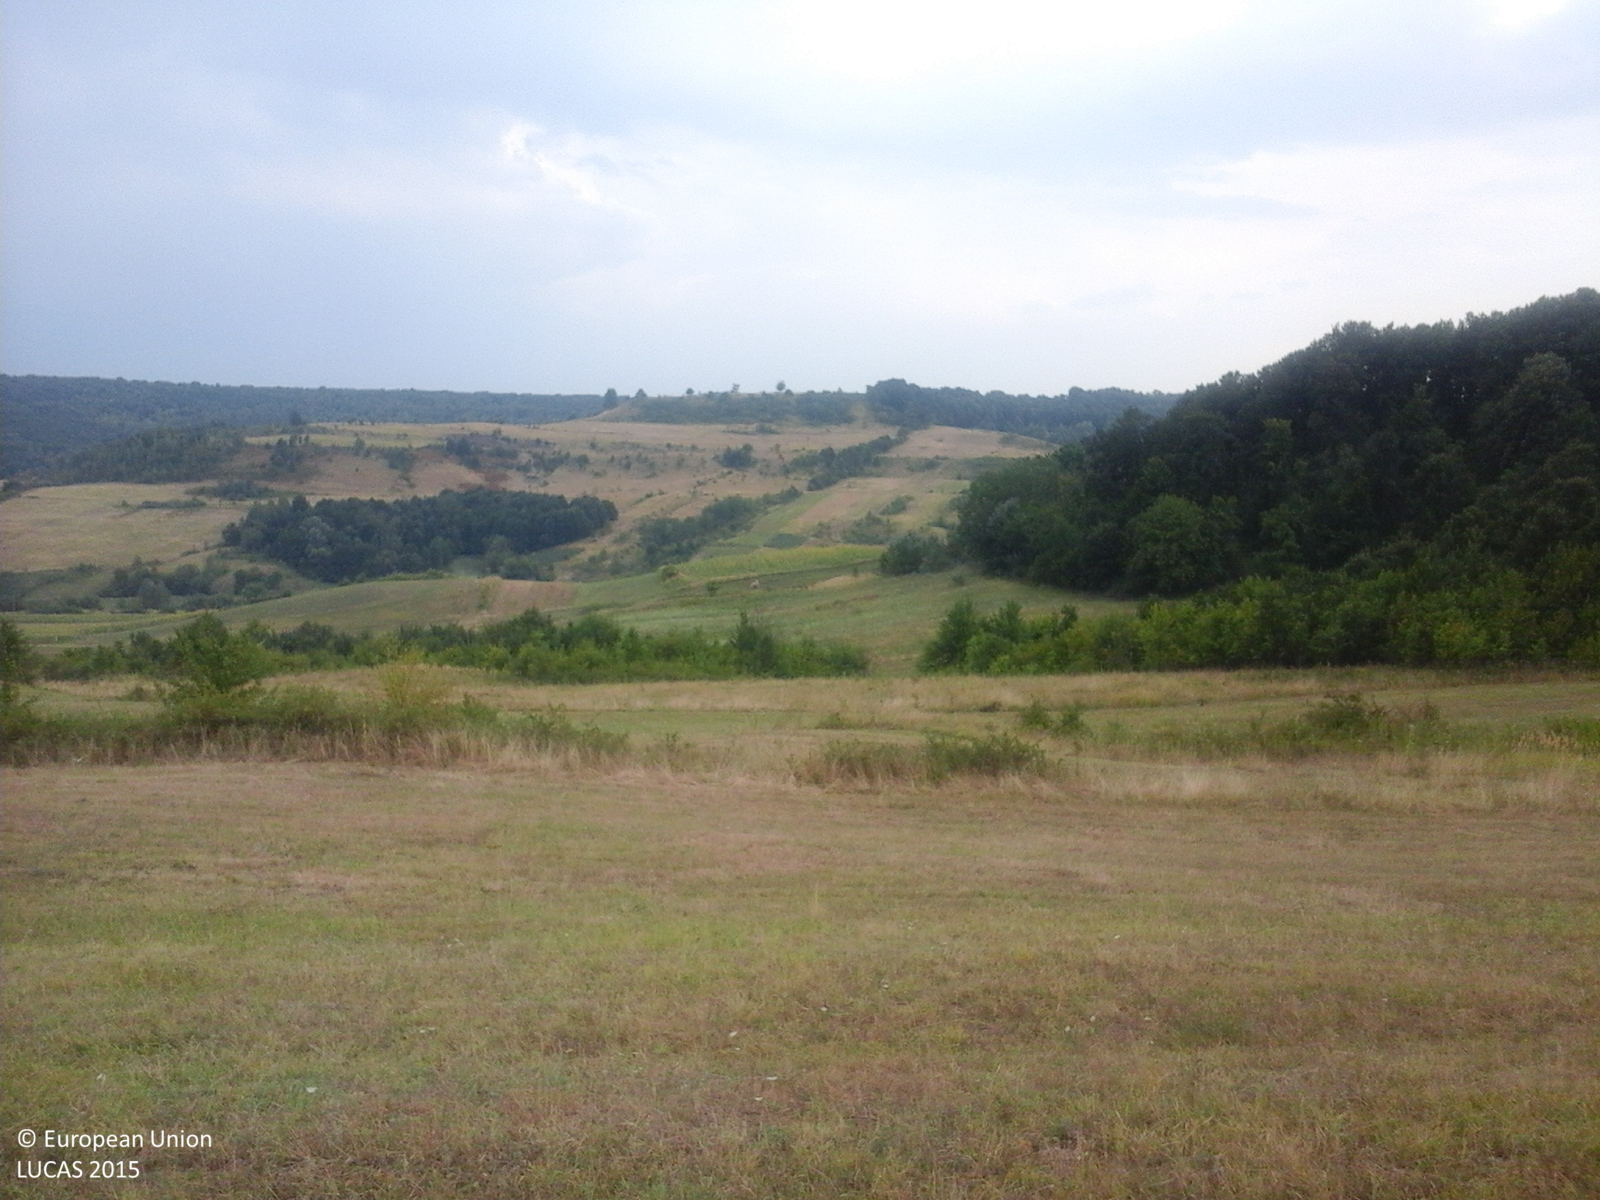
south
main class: Grassland
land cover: Grassland without tree/shrub cover
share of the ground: > 75 %
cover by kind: herbaceous plants 100 %
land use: Agriculture (excluding fallow land and kitchen gardens)
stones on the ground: < 10 %
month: August
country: RO
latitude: 44.6718
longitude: 23.0527
